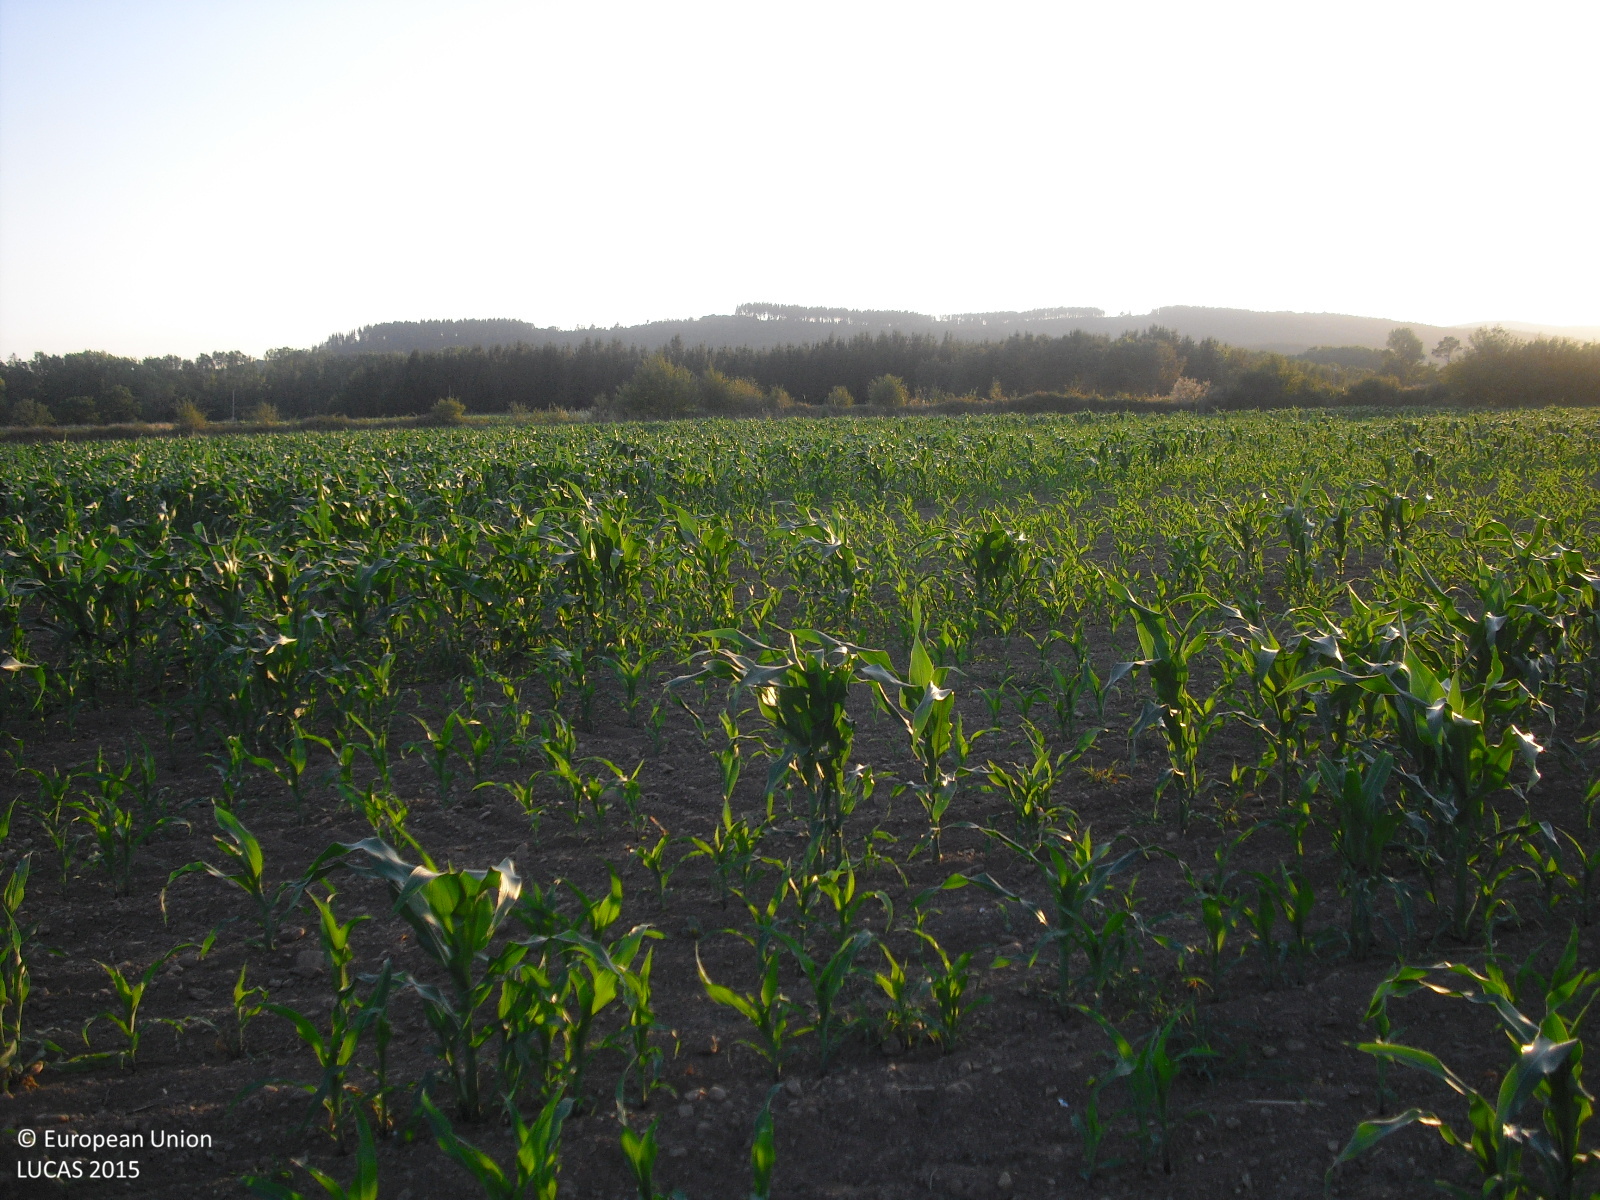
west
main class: Cropland
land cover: Maize
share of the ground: > 75 %
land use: Agriculture (excluding fallow land and kitchen gardens)
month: July
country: ES
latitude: 42.5980
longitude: -7.4610
